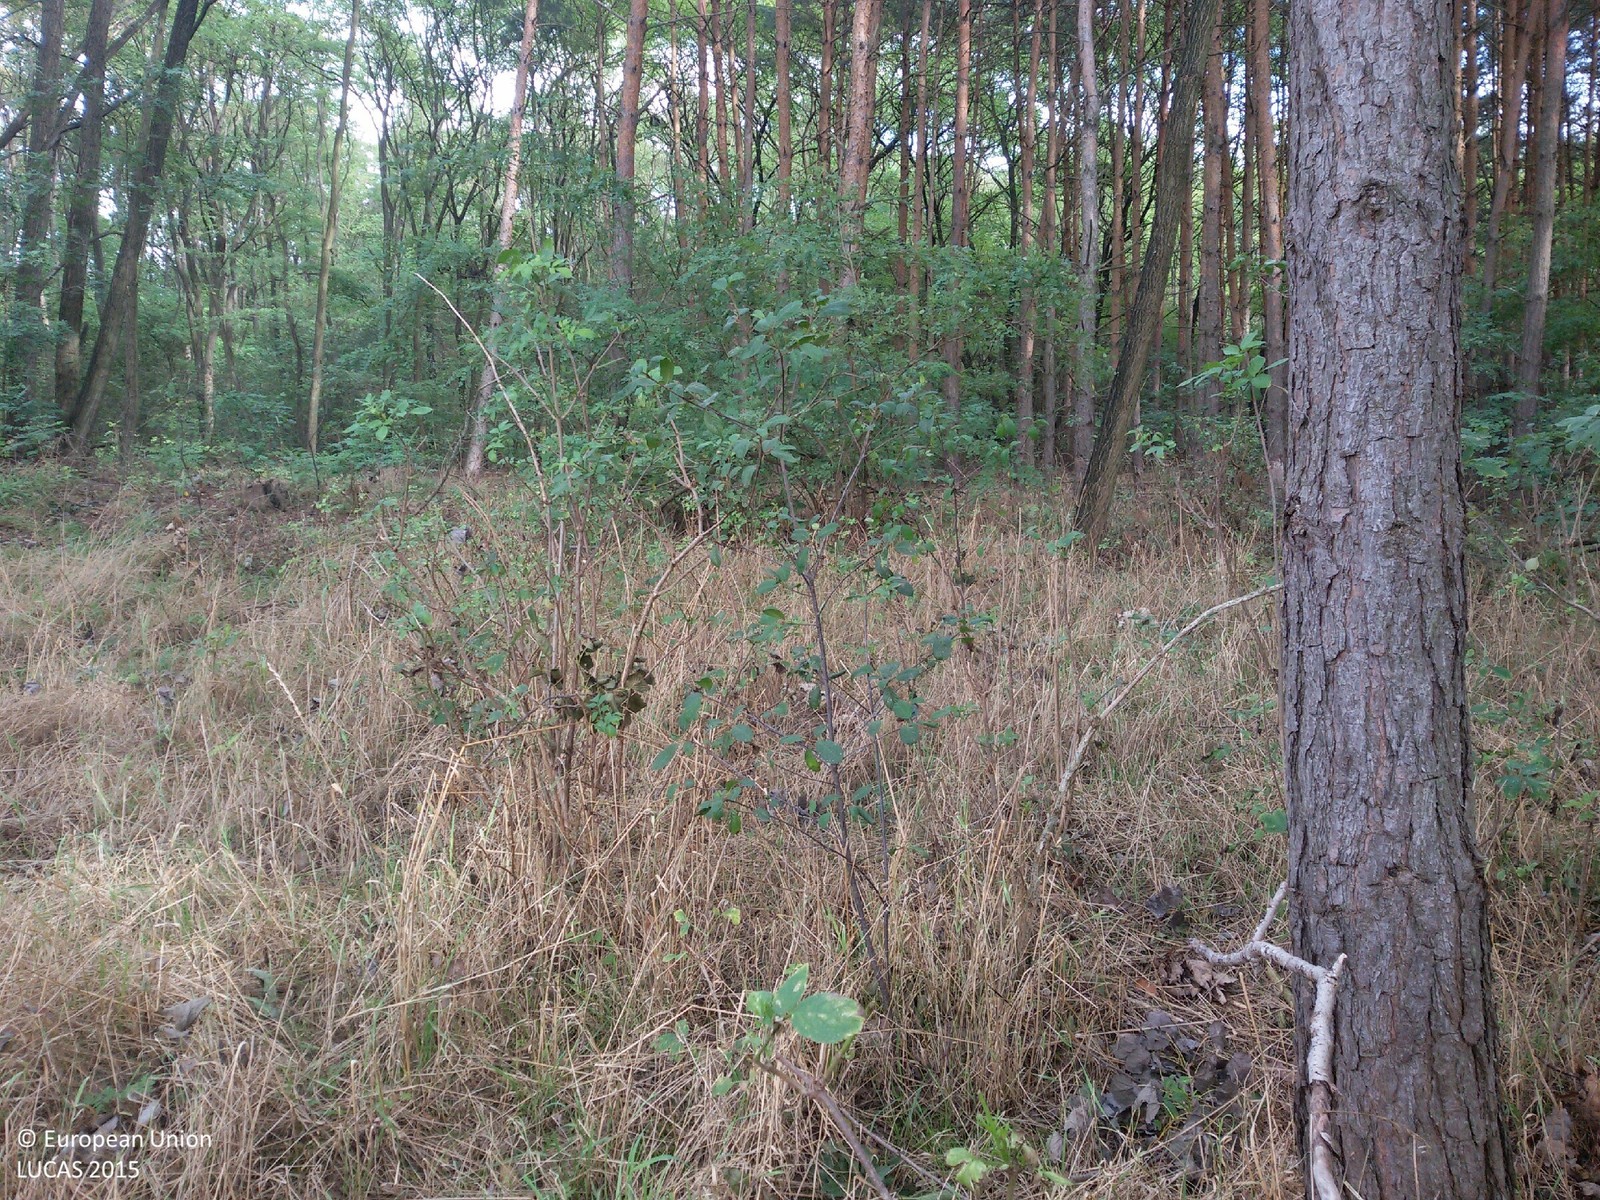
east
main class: Woodland
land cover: Pine dominated mixed woodland
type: hemiboreal forest and nemoral coniferous forest and mixed broadleaved-coniferous forest
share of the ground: 50 - 75 %
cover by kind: coniferous forest trees 55 %, broadleaved forest trees 25 %, shrubs 10 %, herbaceous plants 10 %
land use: Forestry
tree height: > 5 m
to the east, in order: Pine dominated mixed woodland; Tracks; Pine dominated mixed woodland; Tracks
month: September
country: PL
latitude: 52.1037
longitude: 14.7178
